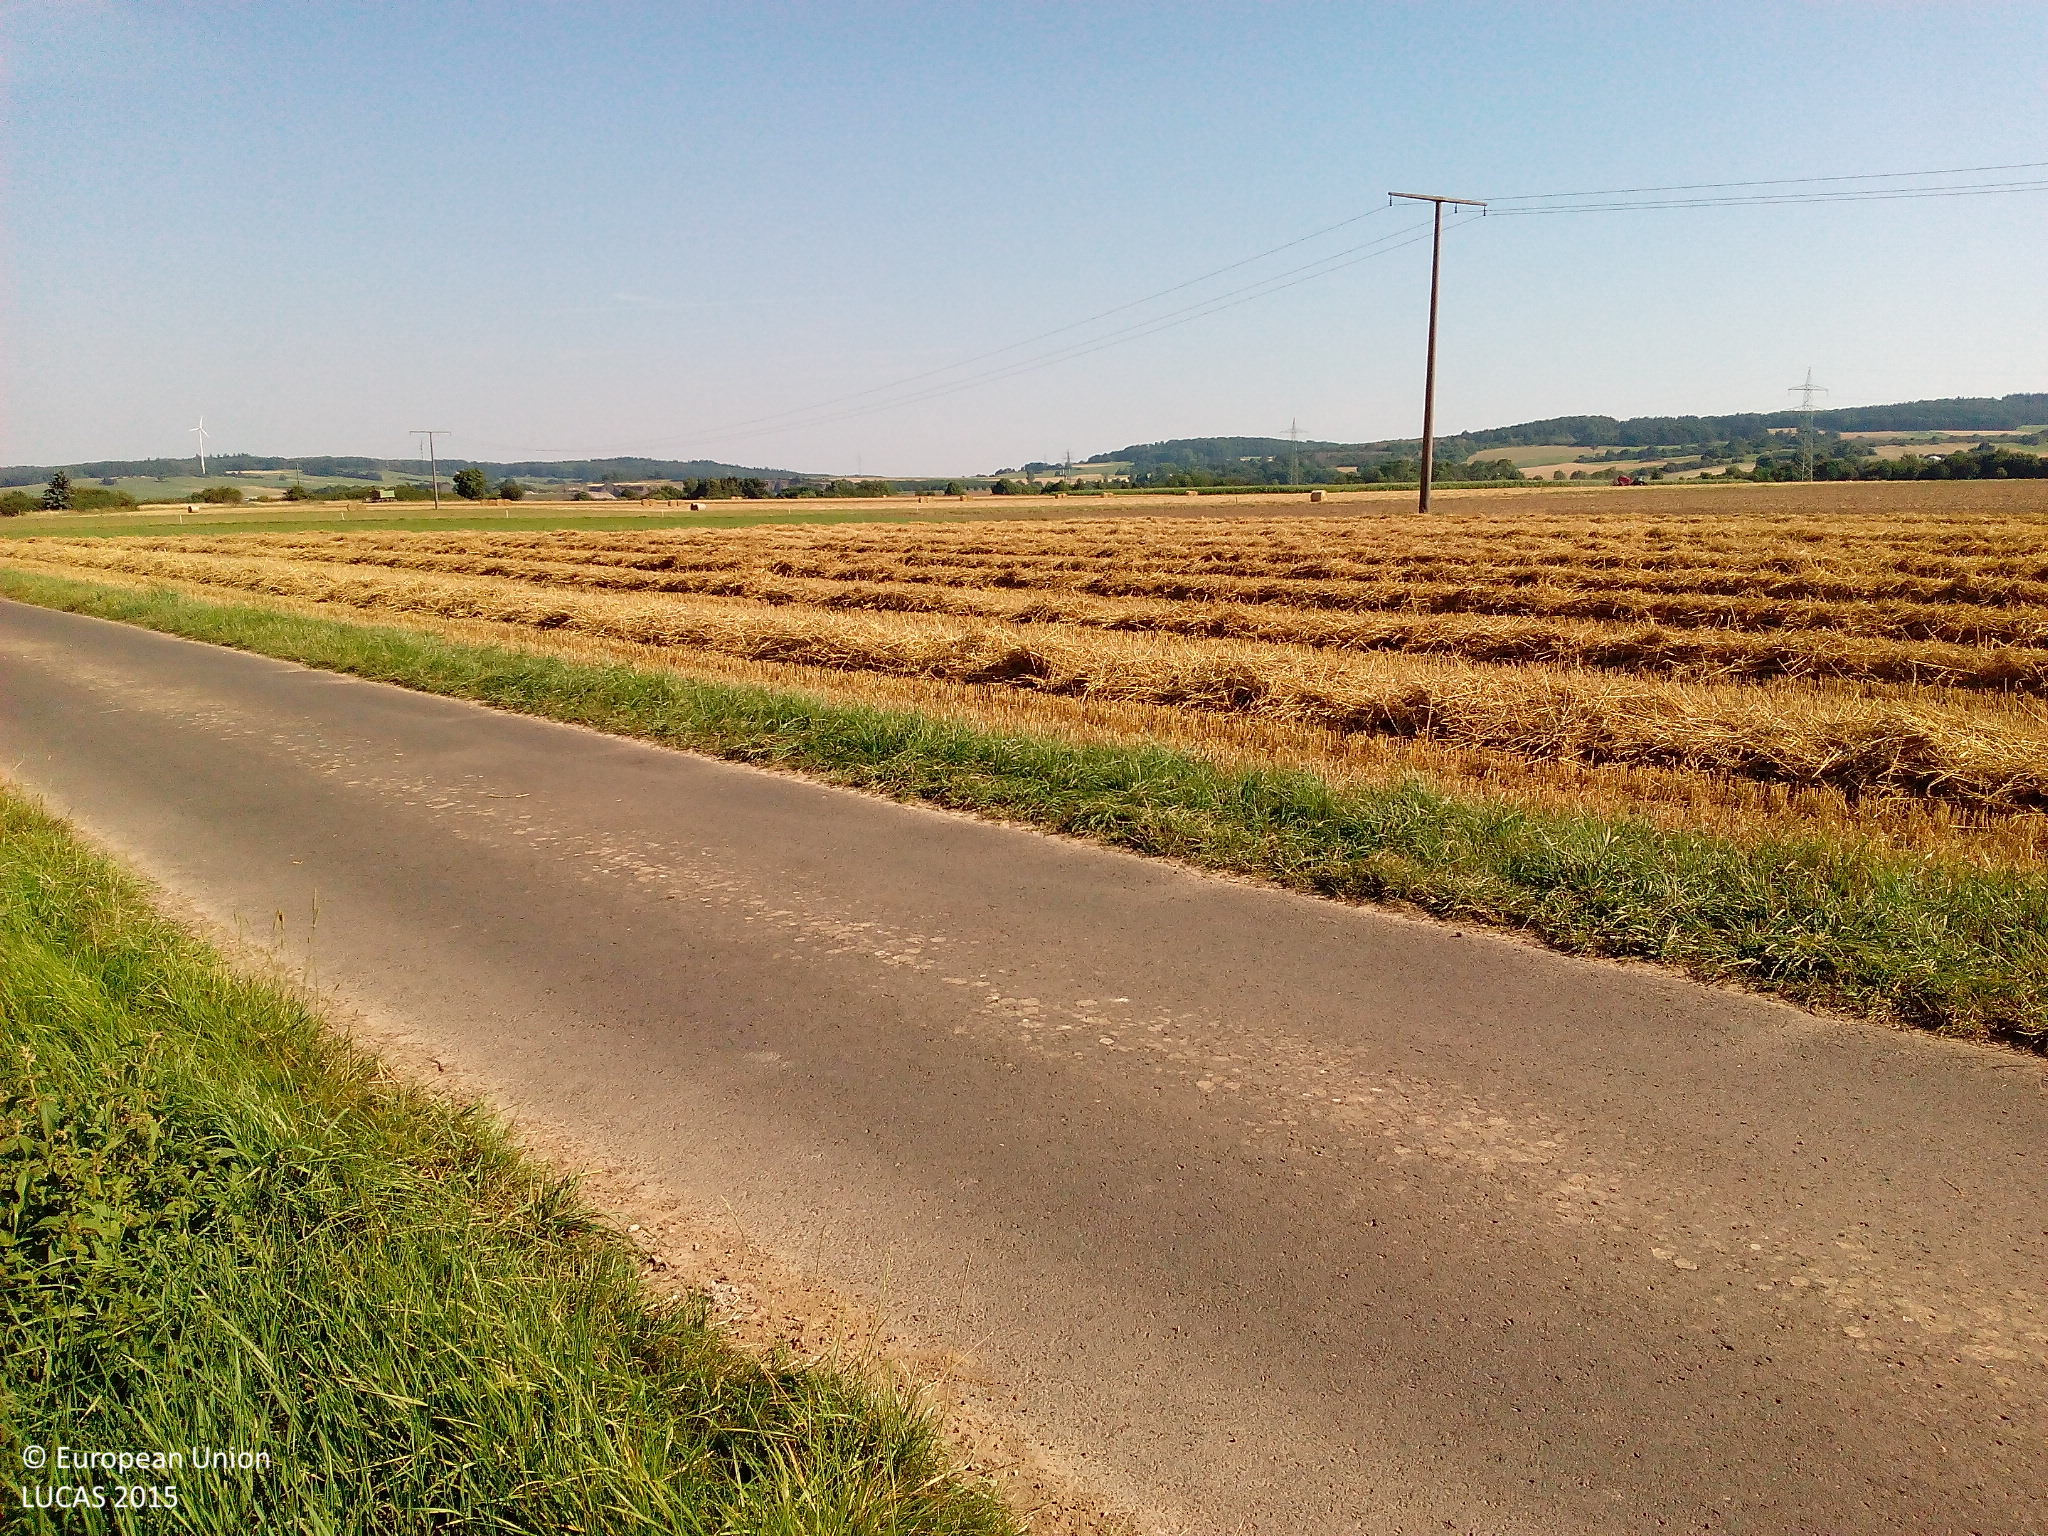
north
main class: Cropland
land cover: Maize
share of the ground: > 75 %
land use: Agriculture (excluding fallow land and kitchen gardens)
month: August
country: DE
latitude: 50.6858
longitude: 9.3350
